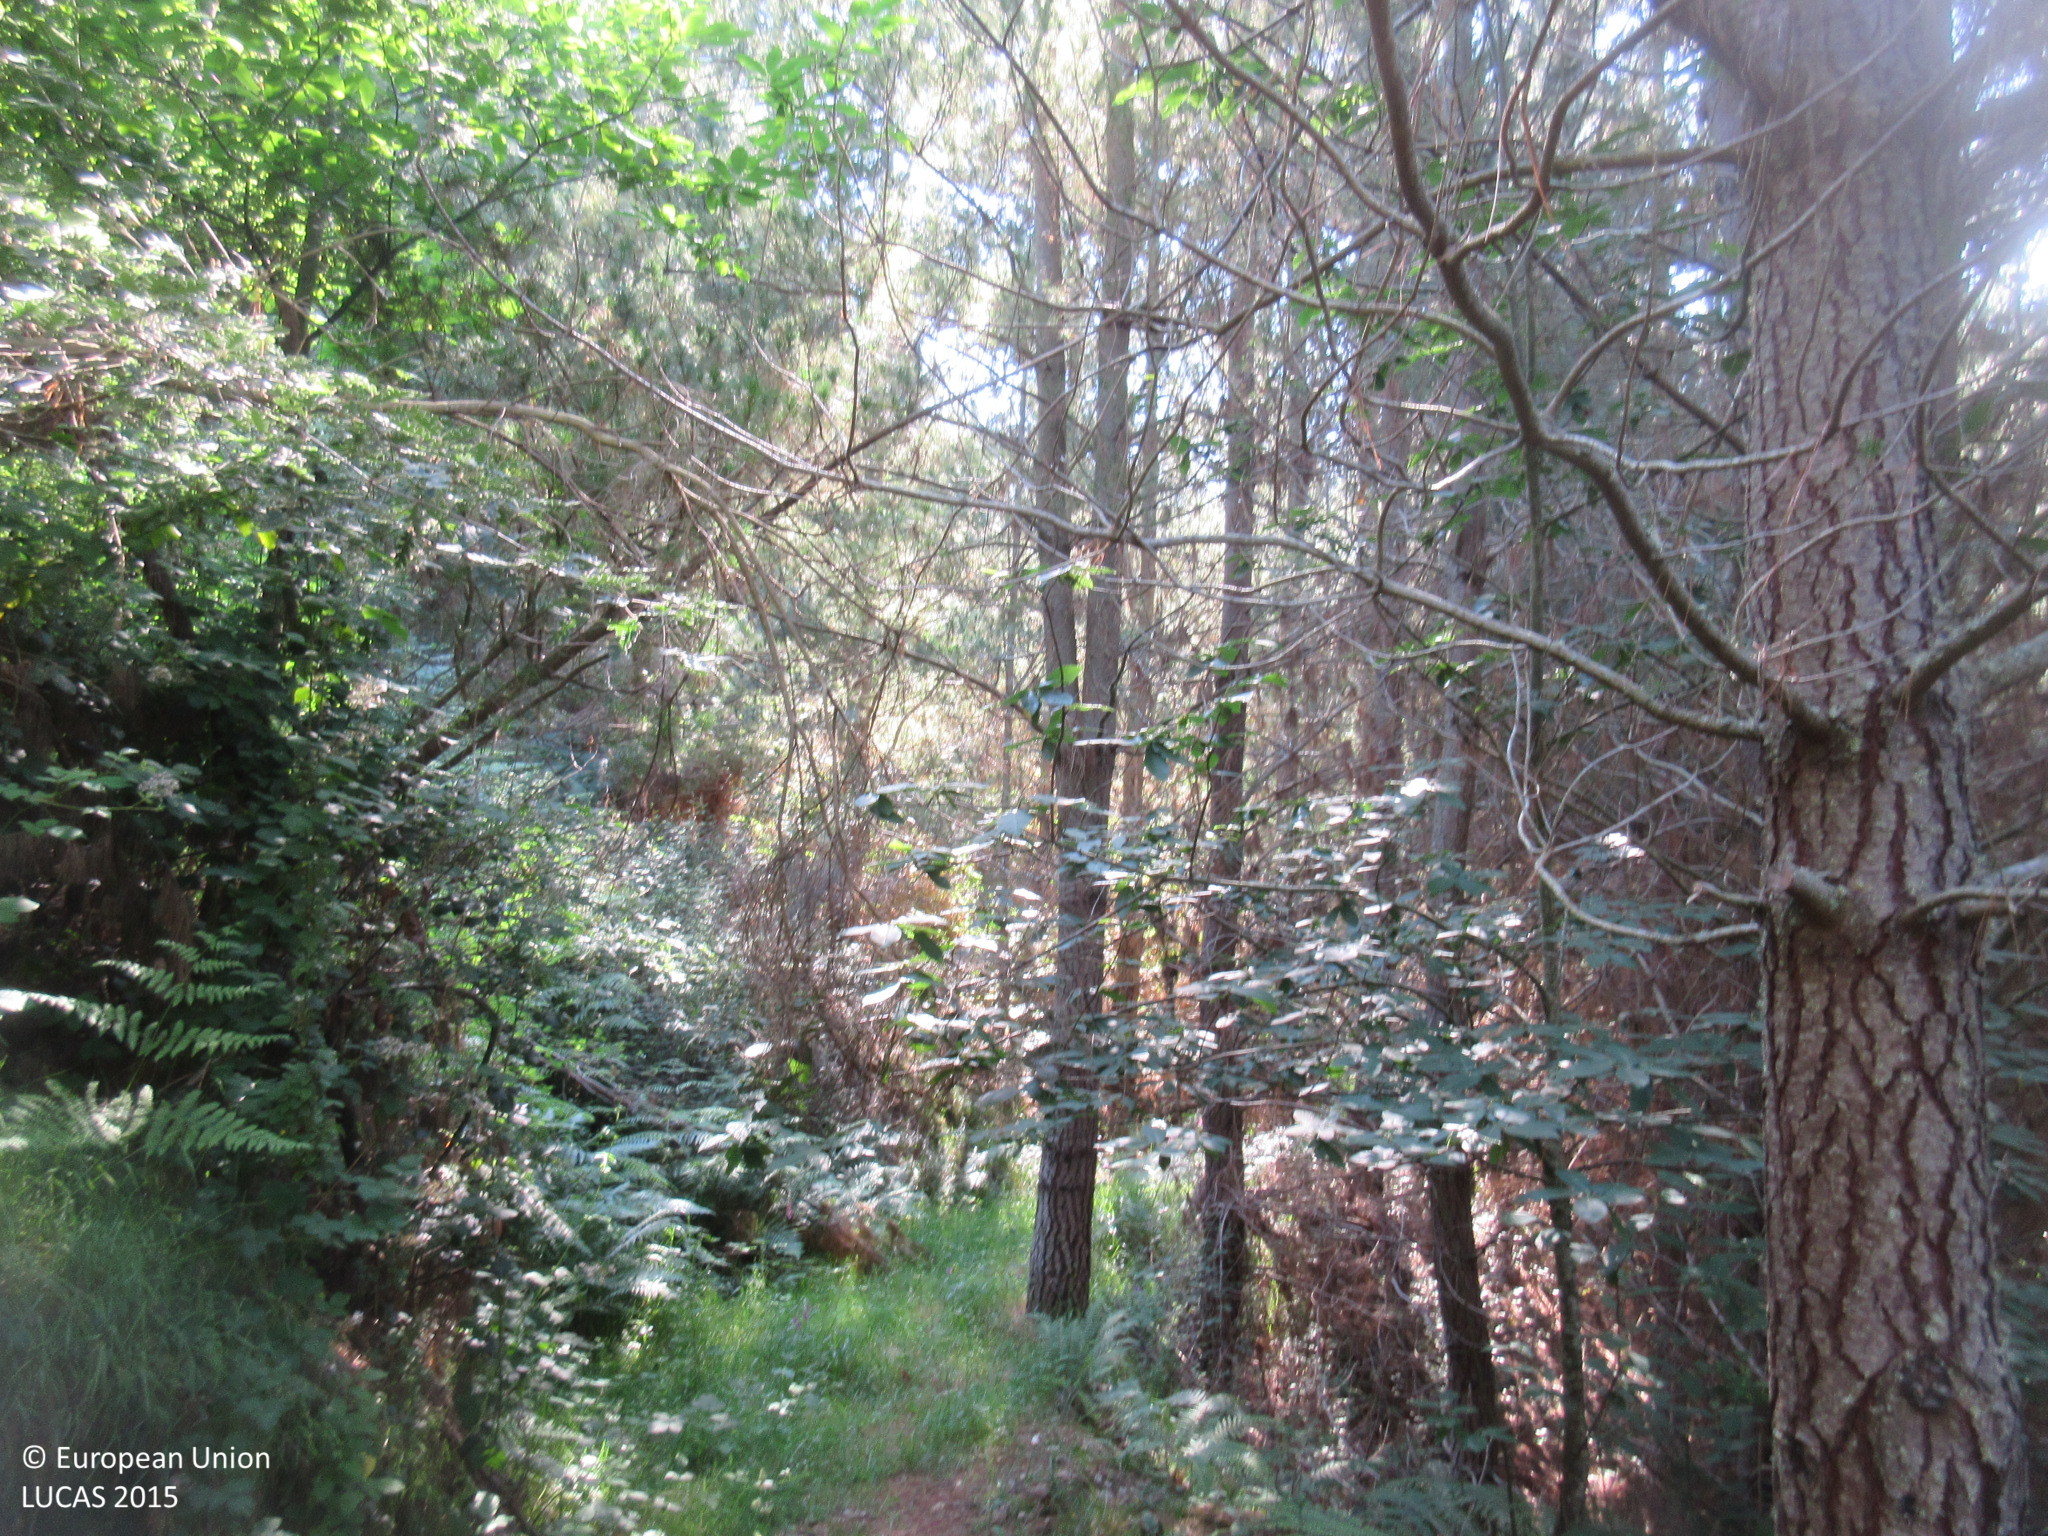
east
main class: Woodland
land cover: Pine dominated mixed woodland
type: hemiboreal forest and nemoral coniferous forest and mixed broadleaved-coniferous forest
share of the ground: > 75 %
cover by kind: coniferous forest trees 55 %, shrubs 25 %, broadleaved forest trees 20 %
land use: Forestry
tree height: > 5 m
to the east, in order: Pine dominated mixed woodland; Broadleaved woodland
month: June
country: ES
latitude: 42.8853
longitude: -6.9689
